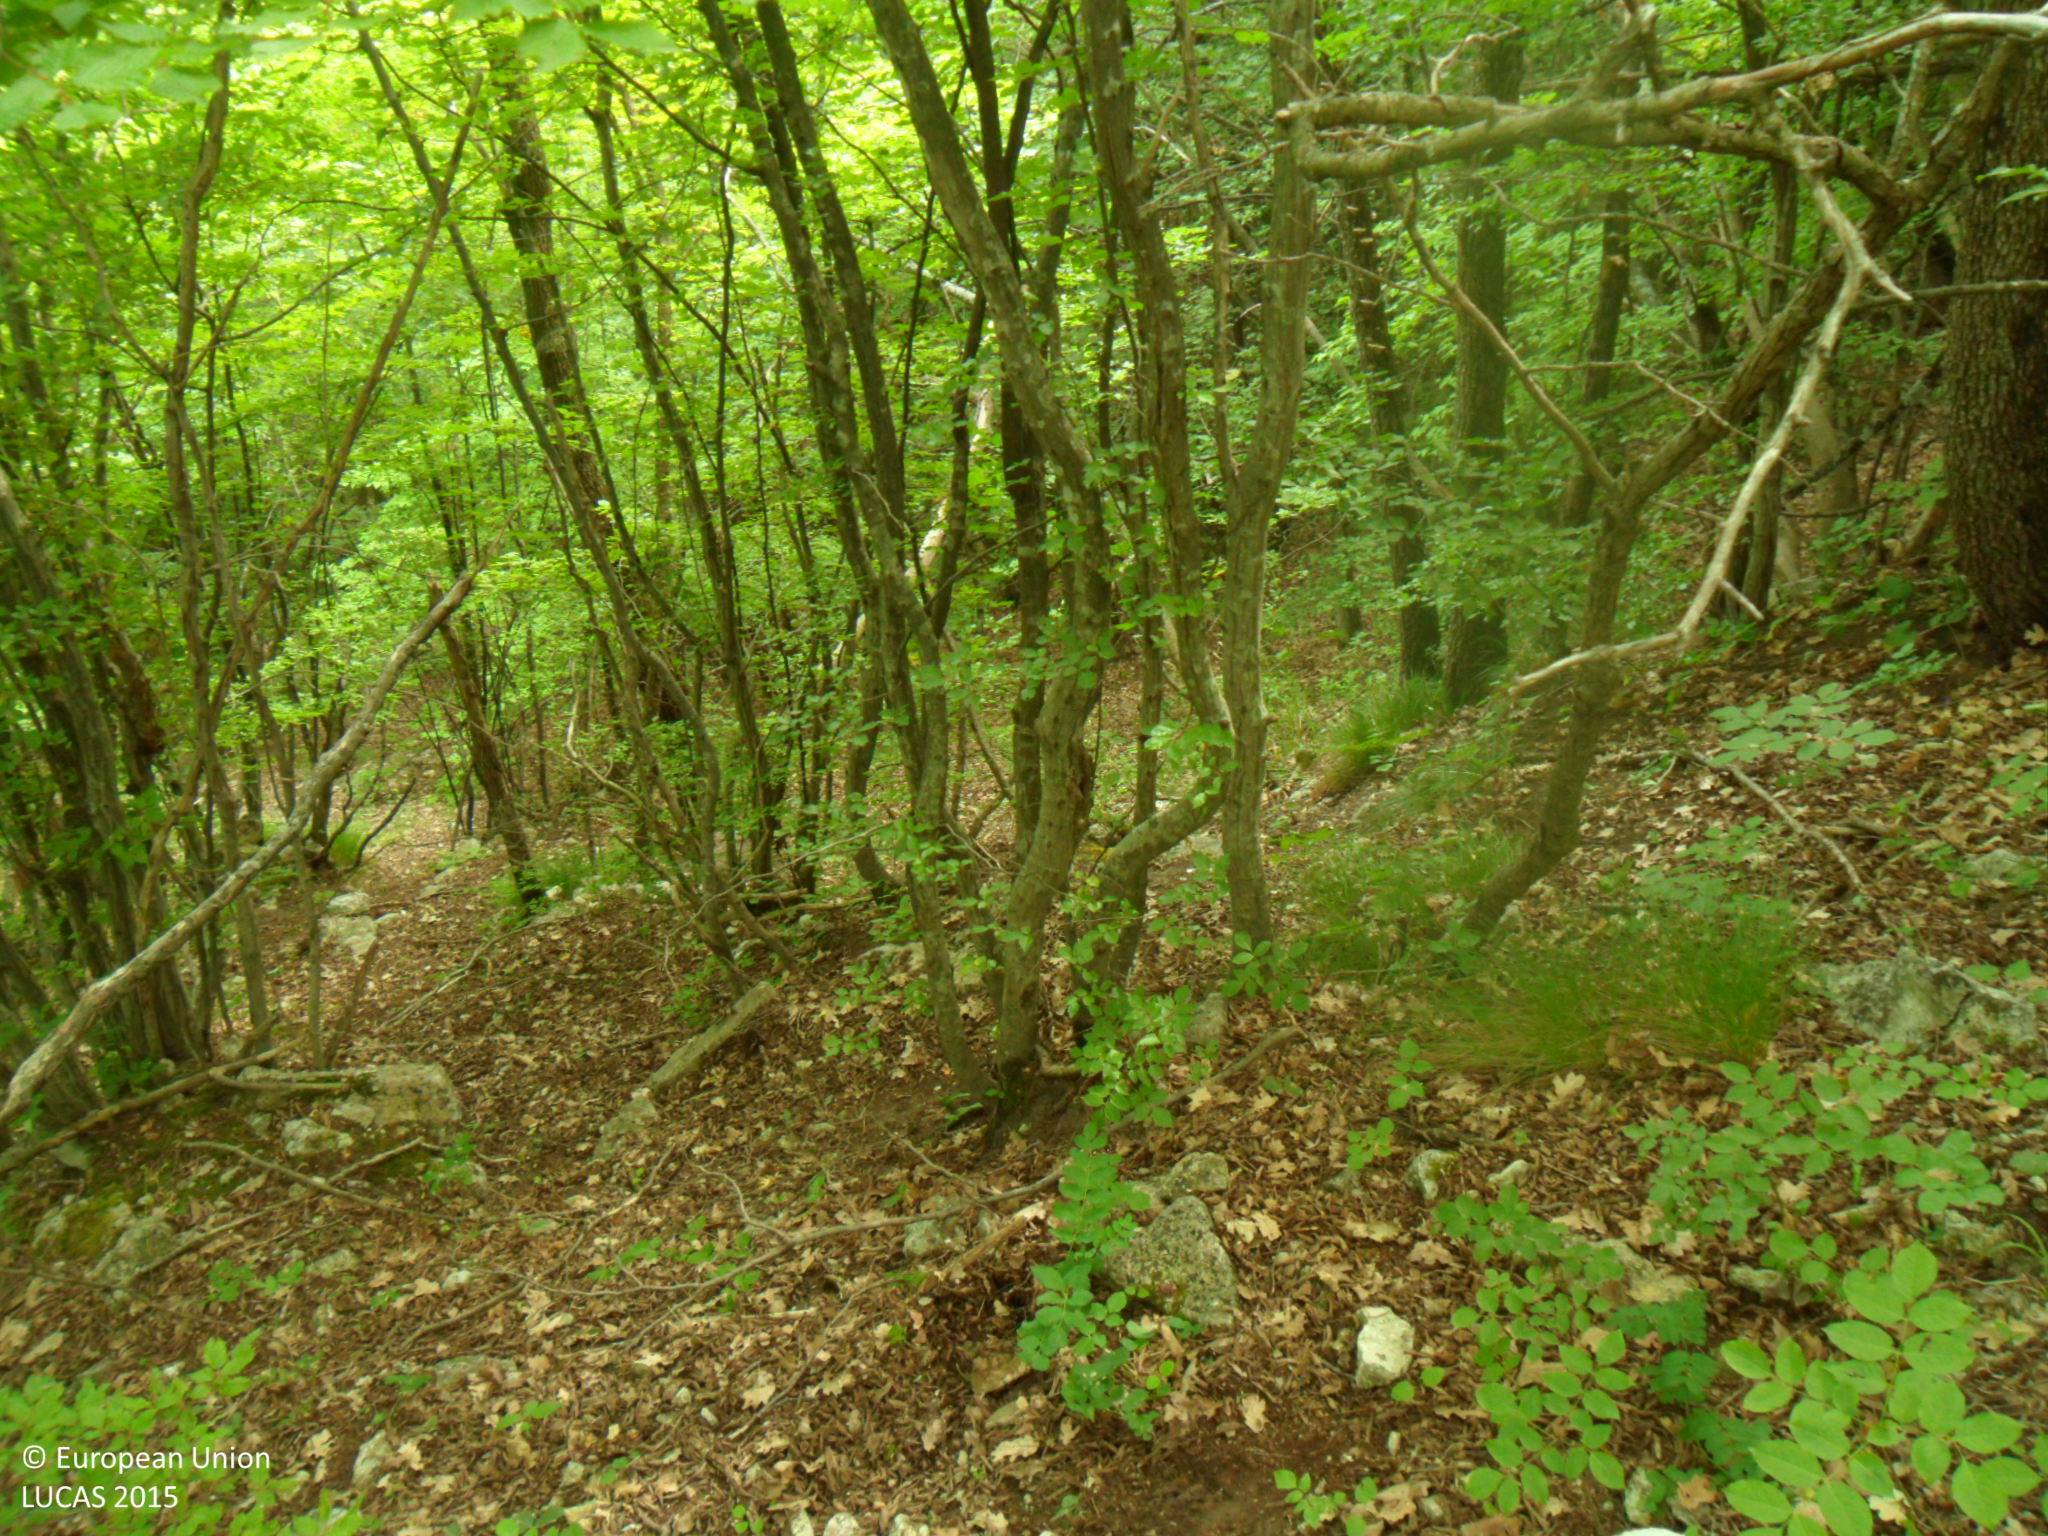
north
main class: Woodland
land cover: Broadleaved woodland
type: beech forest
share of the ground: > 75 %
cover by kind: broadleaved forest trees 100 %
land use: Forestry
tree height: > 5 m
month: June
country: BG
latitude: 43.3195
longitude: 26.7934
